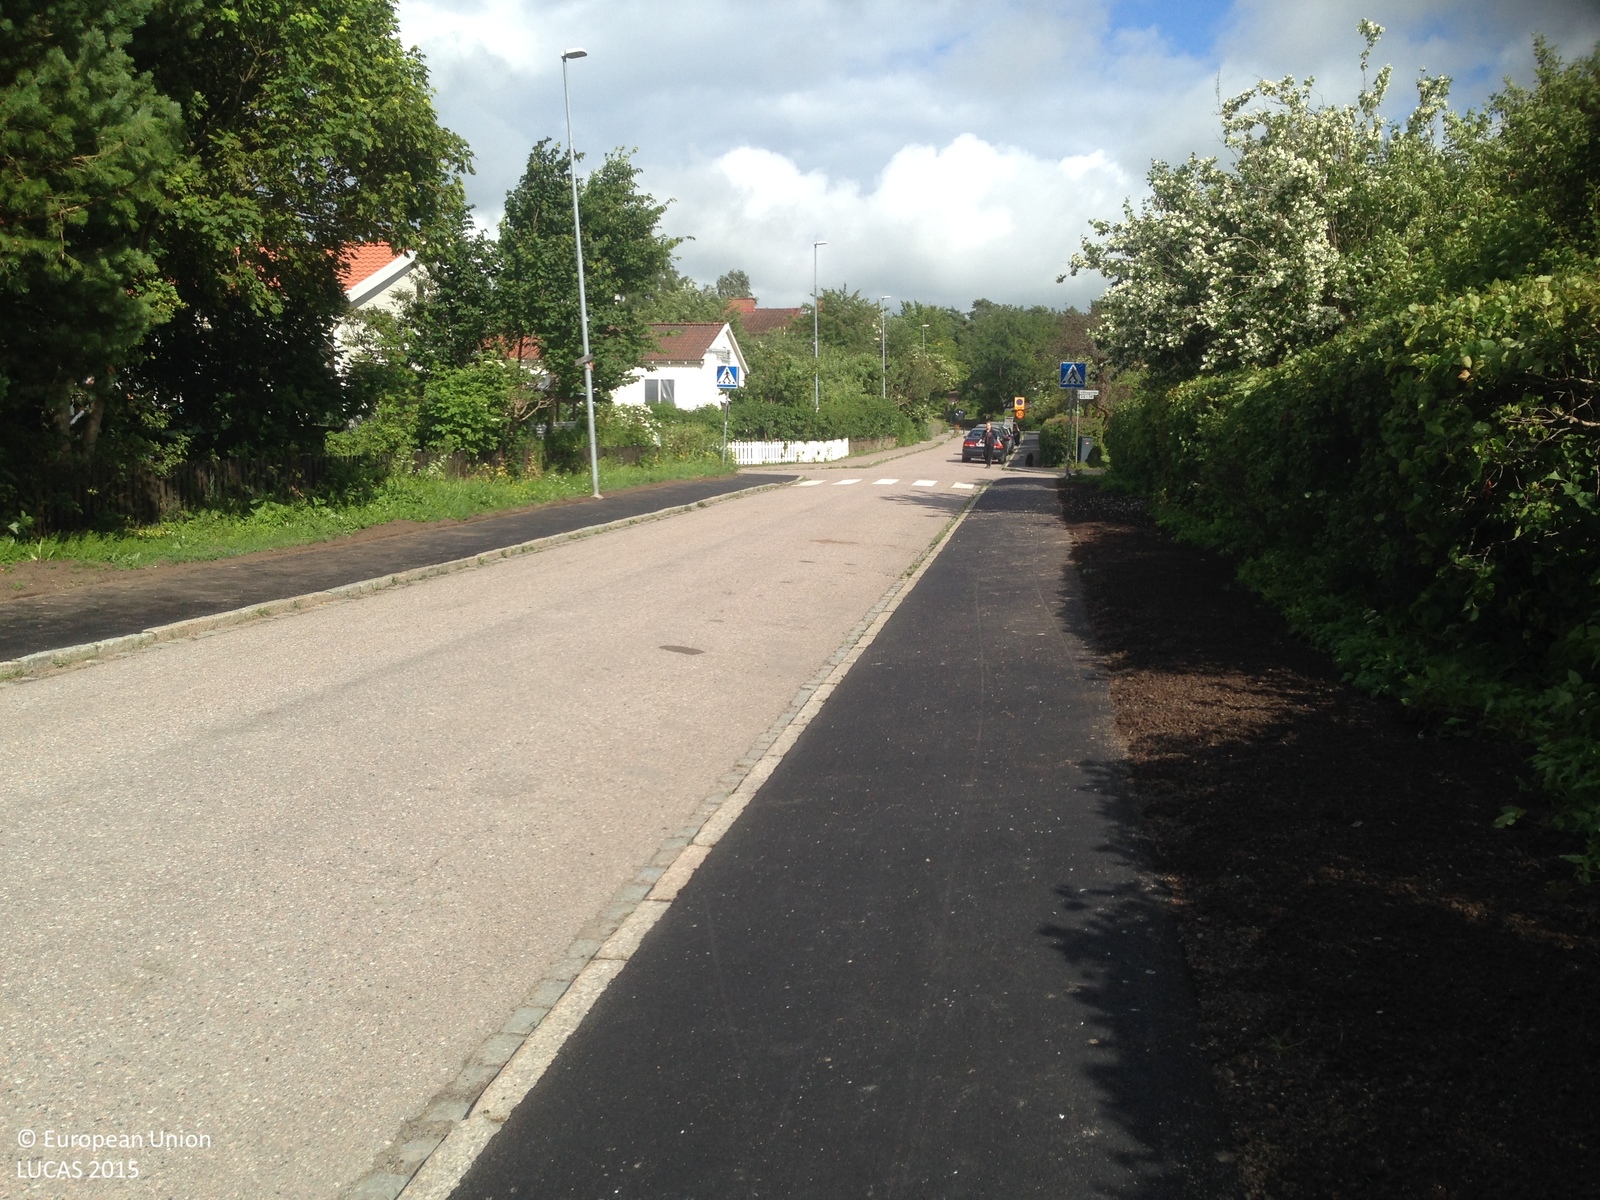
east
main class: Cropland
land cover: Apple fruit
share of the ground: > 75 %
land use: Kitchen garden
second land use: Amenities, museums, leisure
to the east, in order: Apple fruit; Artificial constructions in urban areas
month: July
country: SE
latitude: 59.8481
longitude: 17.6156
